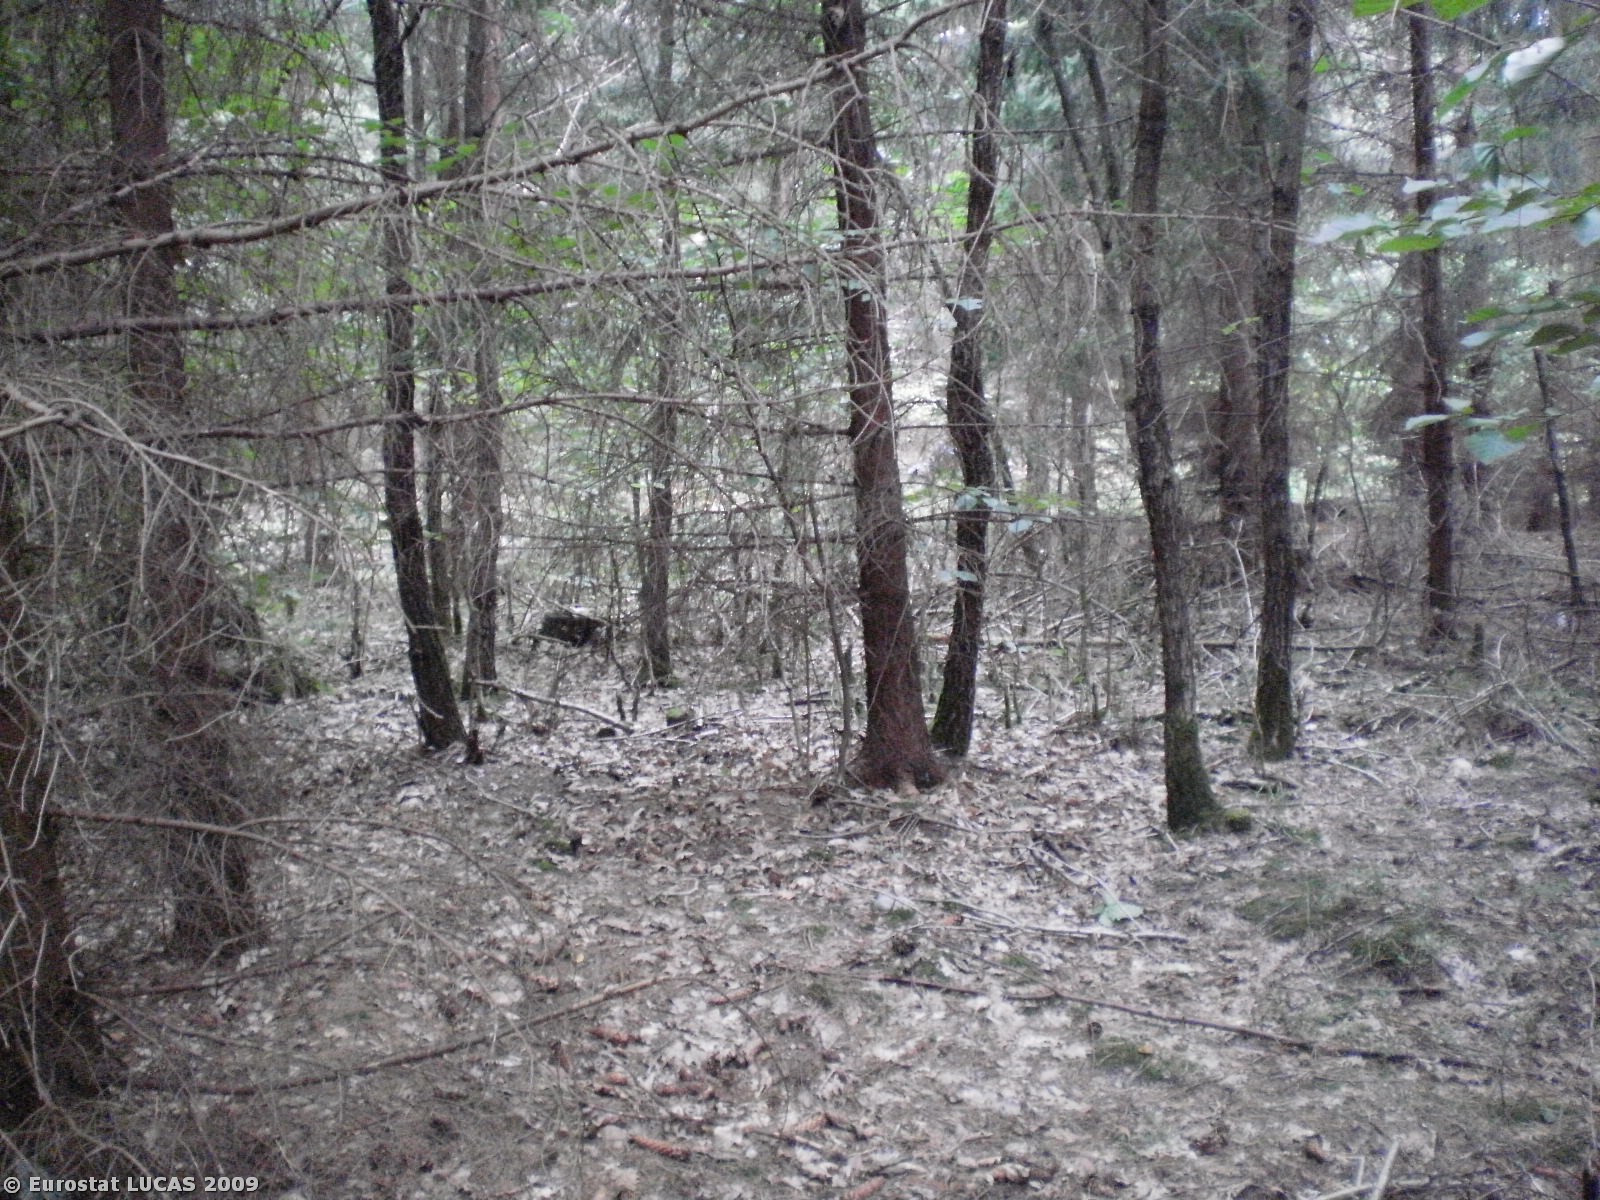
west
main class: Woodland
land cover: Coniferous woodland
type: hemiboreal forest and nemoral coniferous forest and mixed broadleaved-coniferous forest
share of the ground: > 75 %
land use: Forestry
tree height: > 5 m
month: September
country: PL
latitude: 53.7687
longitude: 21.4120
